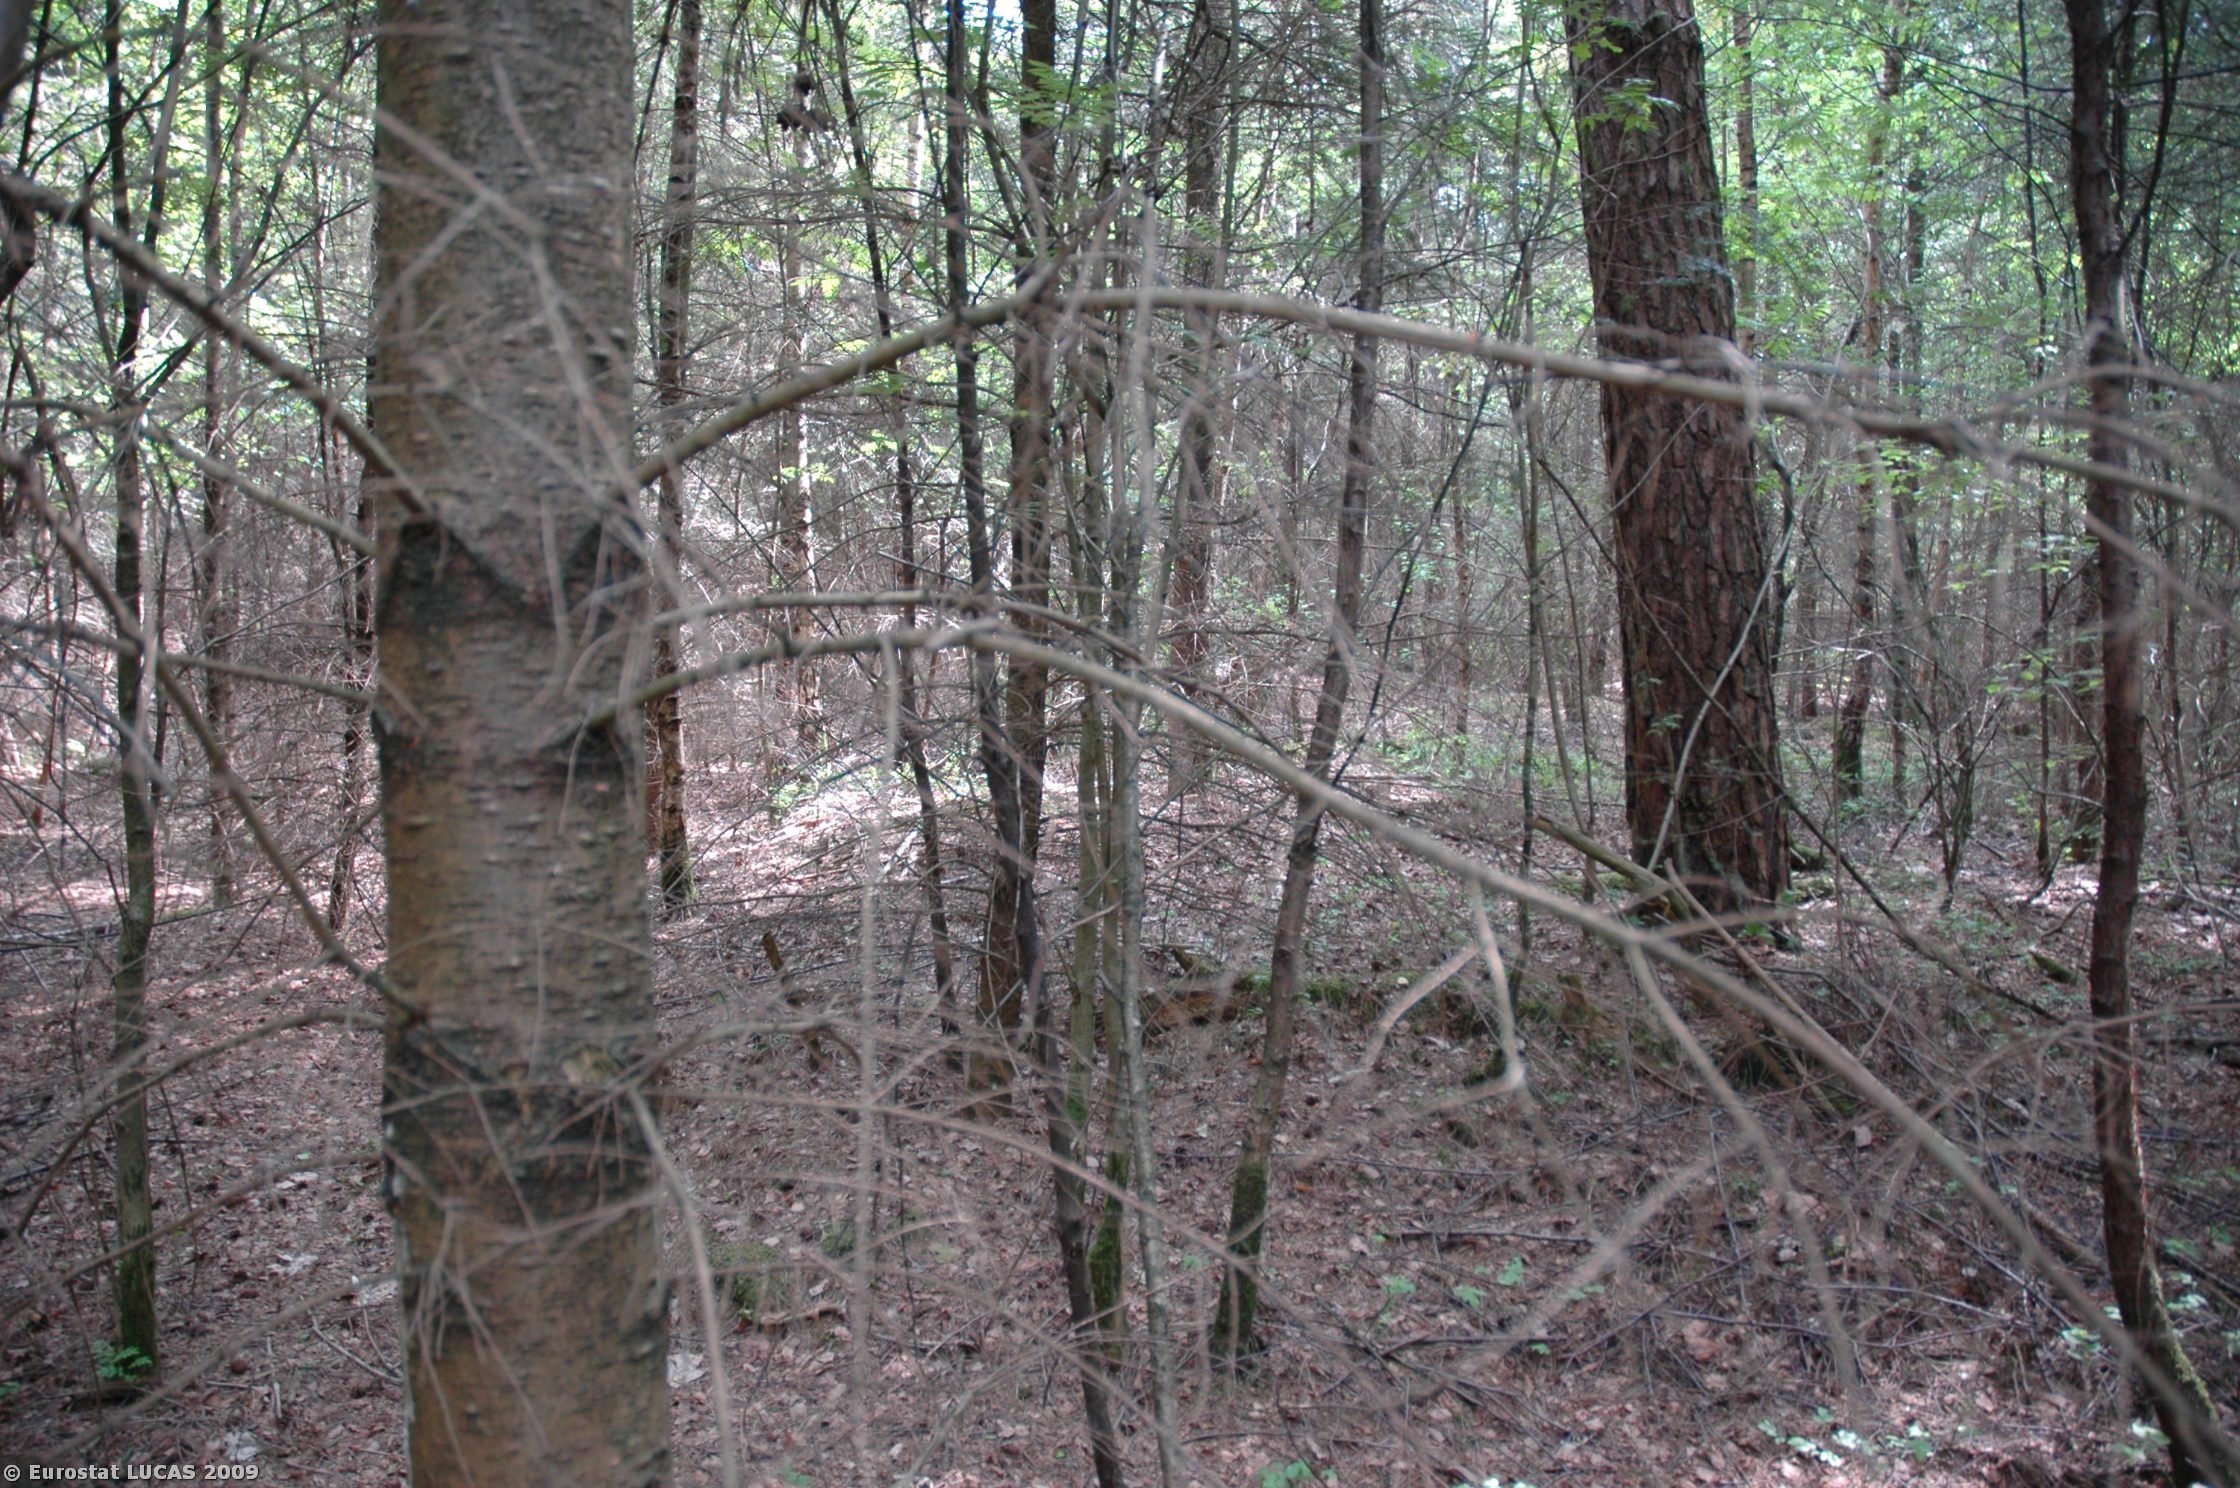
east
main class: Woodland
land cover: Mixed woodland
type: hemiboreal forest and nemoral coniferous forest and mixed broadleaved-coniferous forest
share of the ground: > 75 %
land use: Amenities, museums, leisure
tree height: > 5 m
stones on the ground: < 10 %
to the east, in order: Mixed woodland
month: May
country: NL
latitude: 52.0881
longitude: 5.3423
